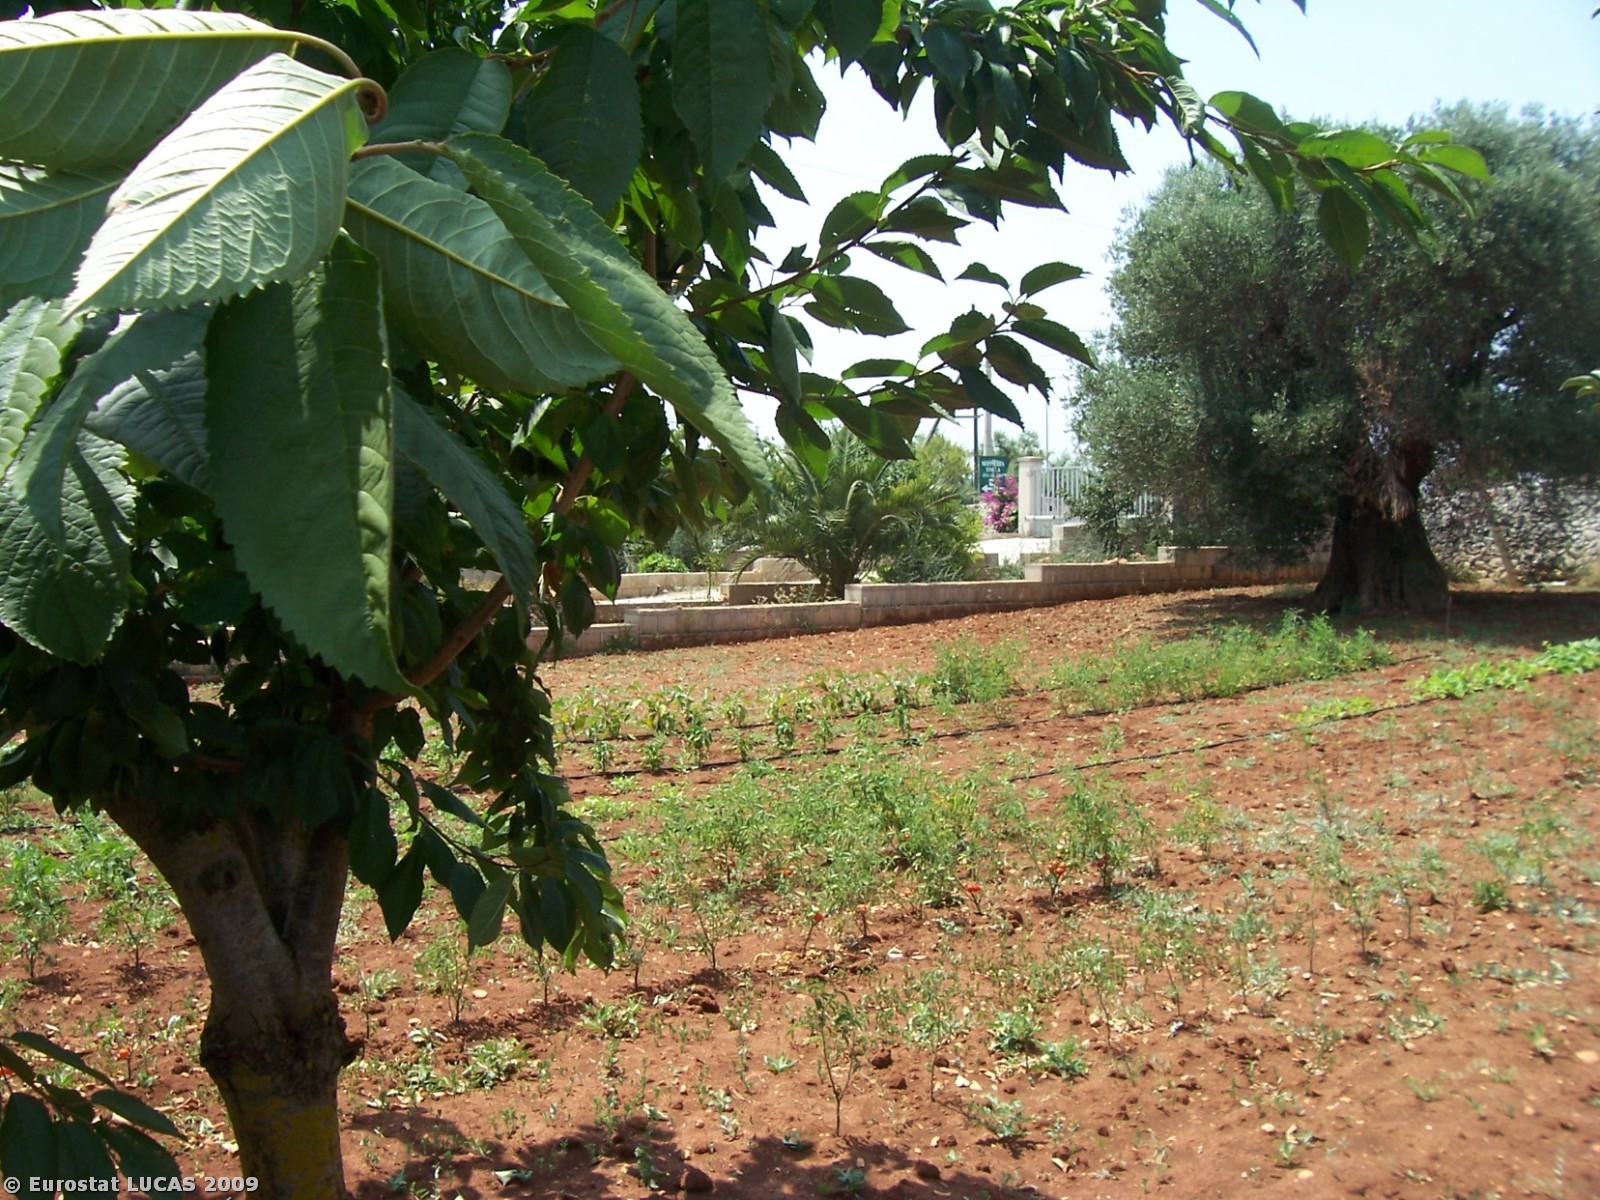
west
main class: Cropland
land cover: Cherry fruit
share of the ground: 50 - 75 %
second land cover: Other fruit trees and berries
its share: > 75 %
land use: Kitchen garden
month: July
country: IT
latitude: 40.7196
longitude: 17.5657
